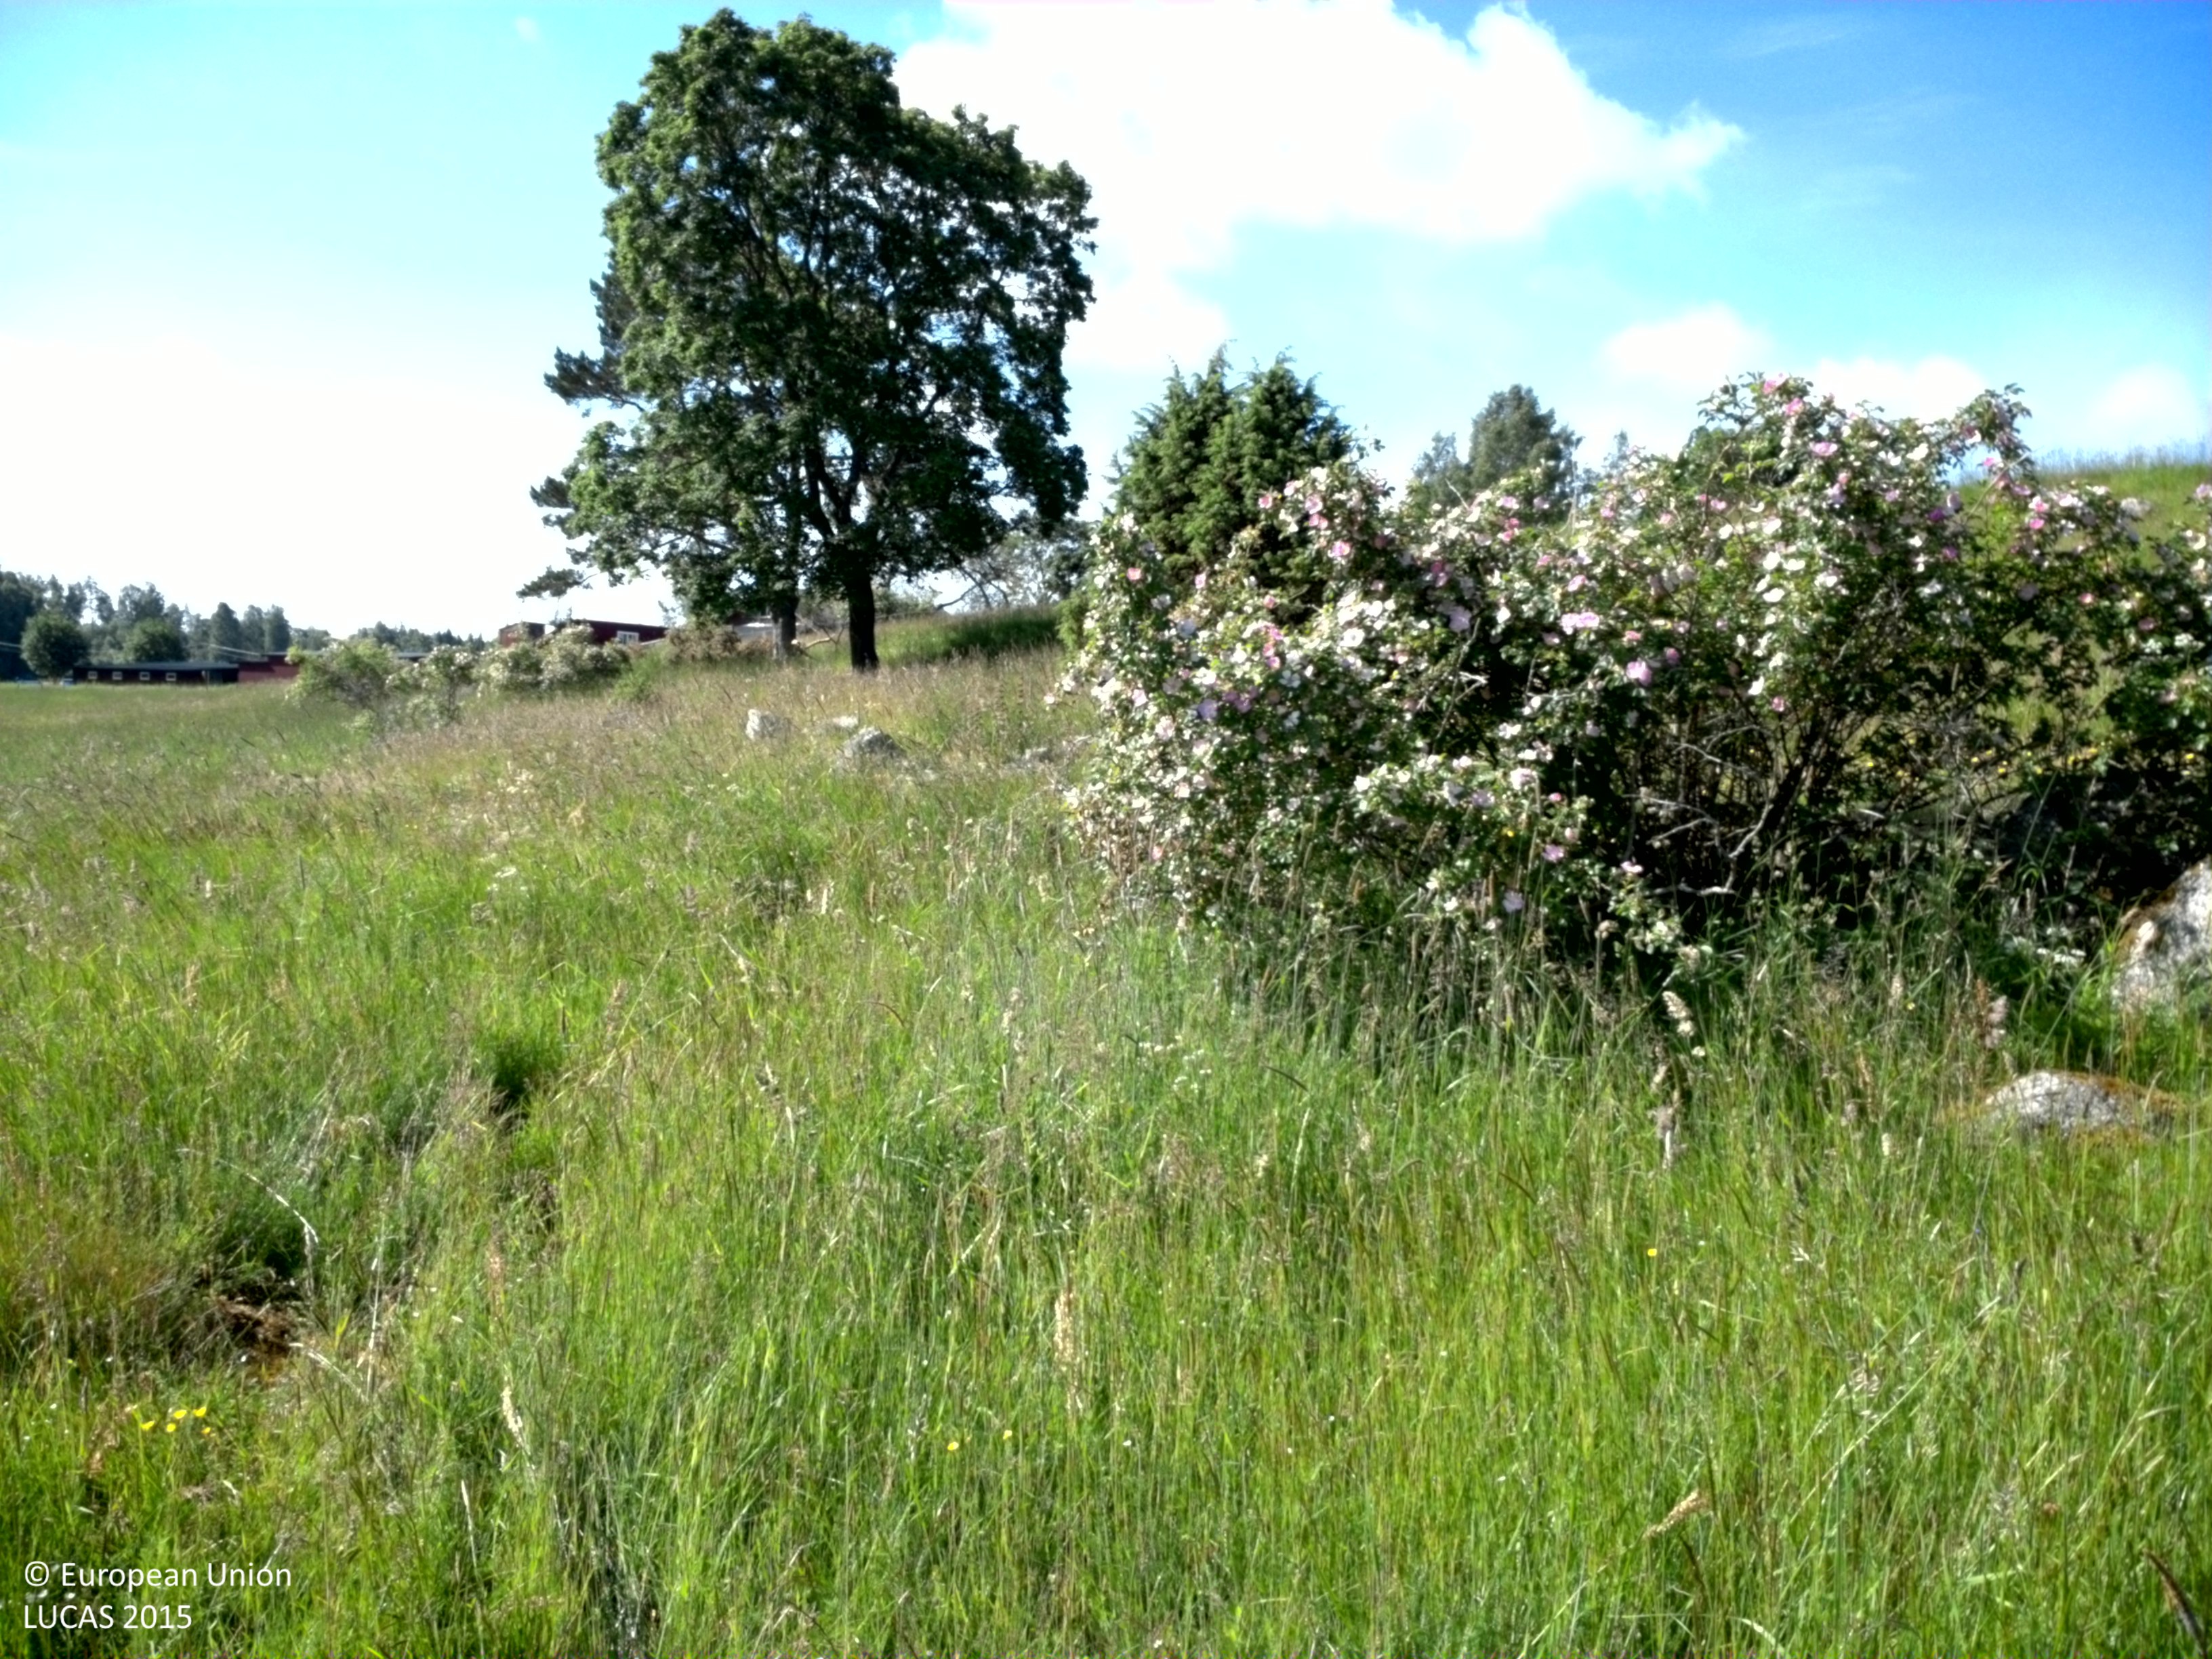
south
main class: Grassland
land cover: Grassland without tree/shrub cover
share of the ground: > 75 %
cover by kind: herbaceous plants 100 %
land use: Agriculture (excluding fallow land and kitchen gardens)
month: June
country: SE
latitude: 59.6608
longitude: 18.3582
